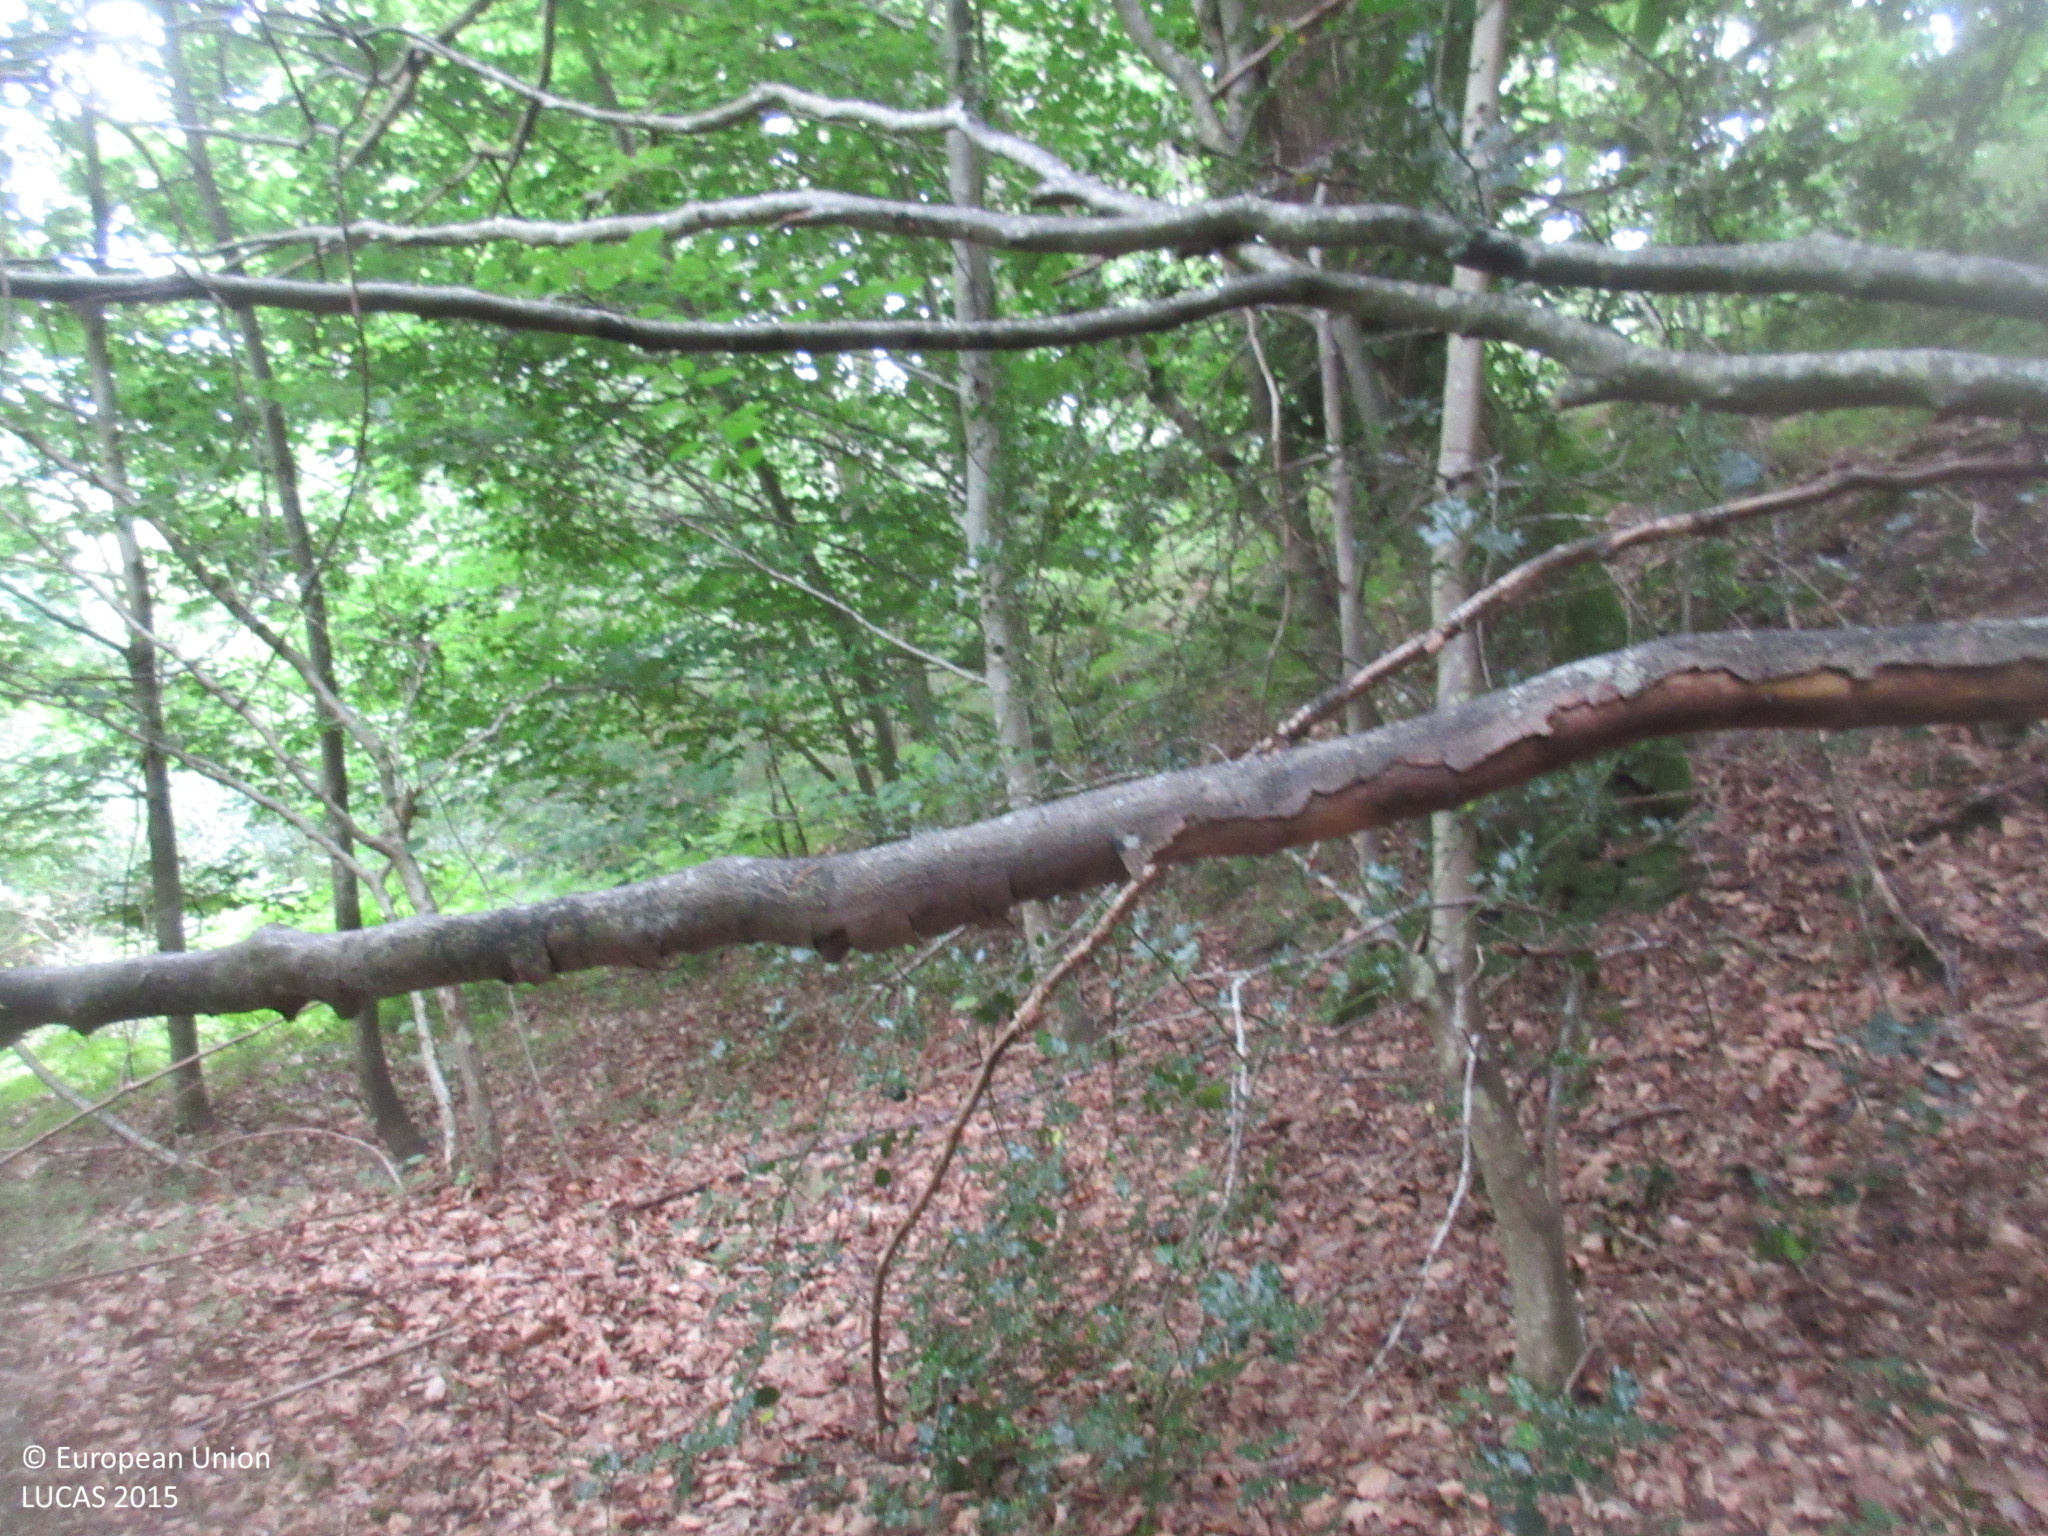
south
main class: Woodland
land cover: Broadleaved woodland
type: beech forest
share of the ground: > 75 %
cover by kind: broadleaved forest trees 95 %, shrubs 5 %
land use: Forestry
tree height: > 5 m
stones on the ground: 10 - 25 %
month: July
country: ES
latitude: 43.1909
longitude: -3.4908
